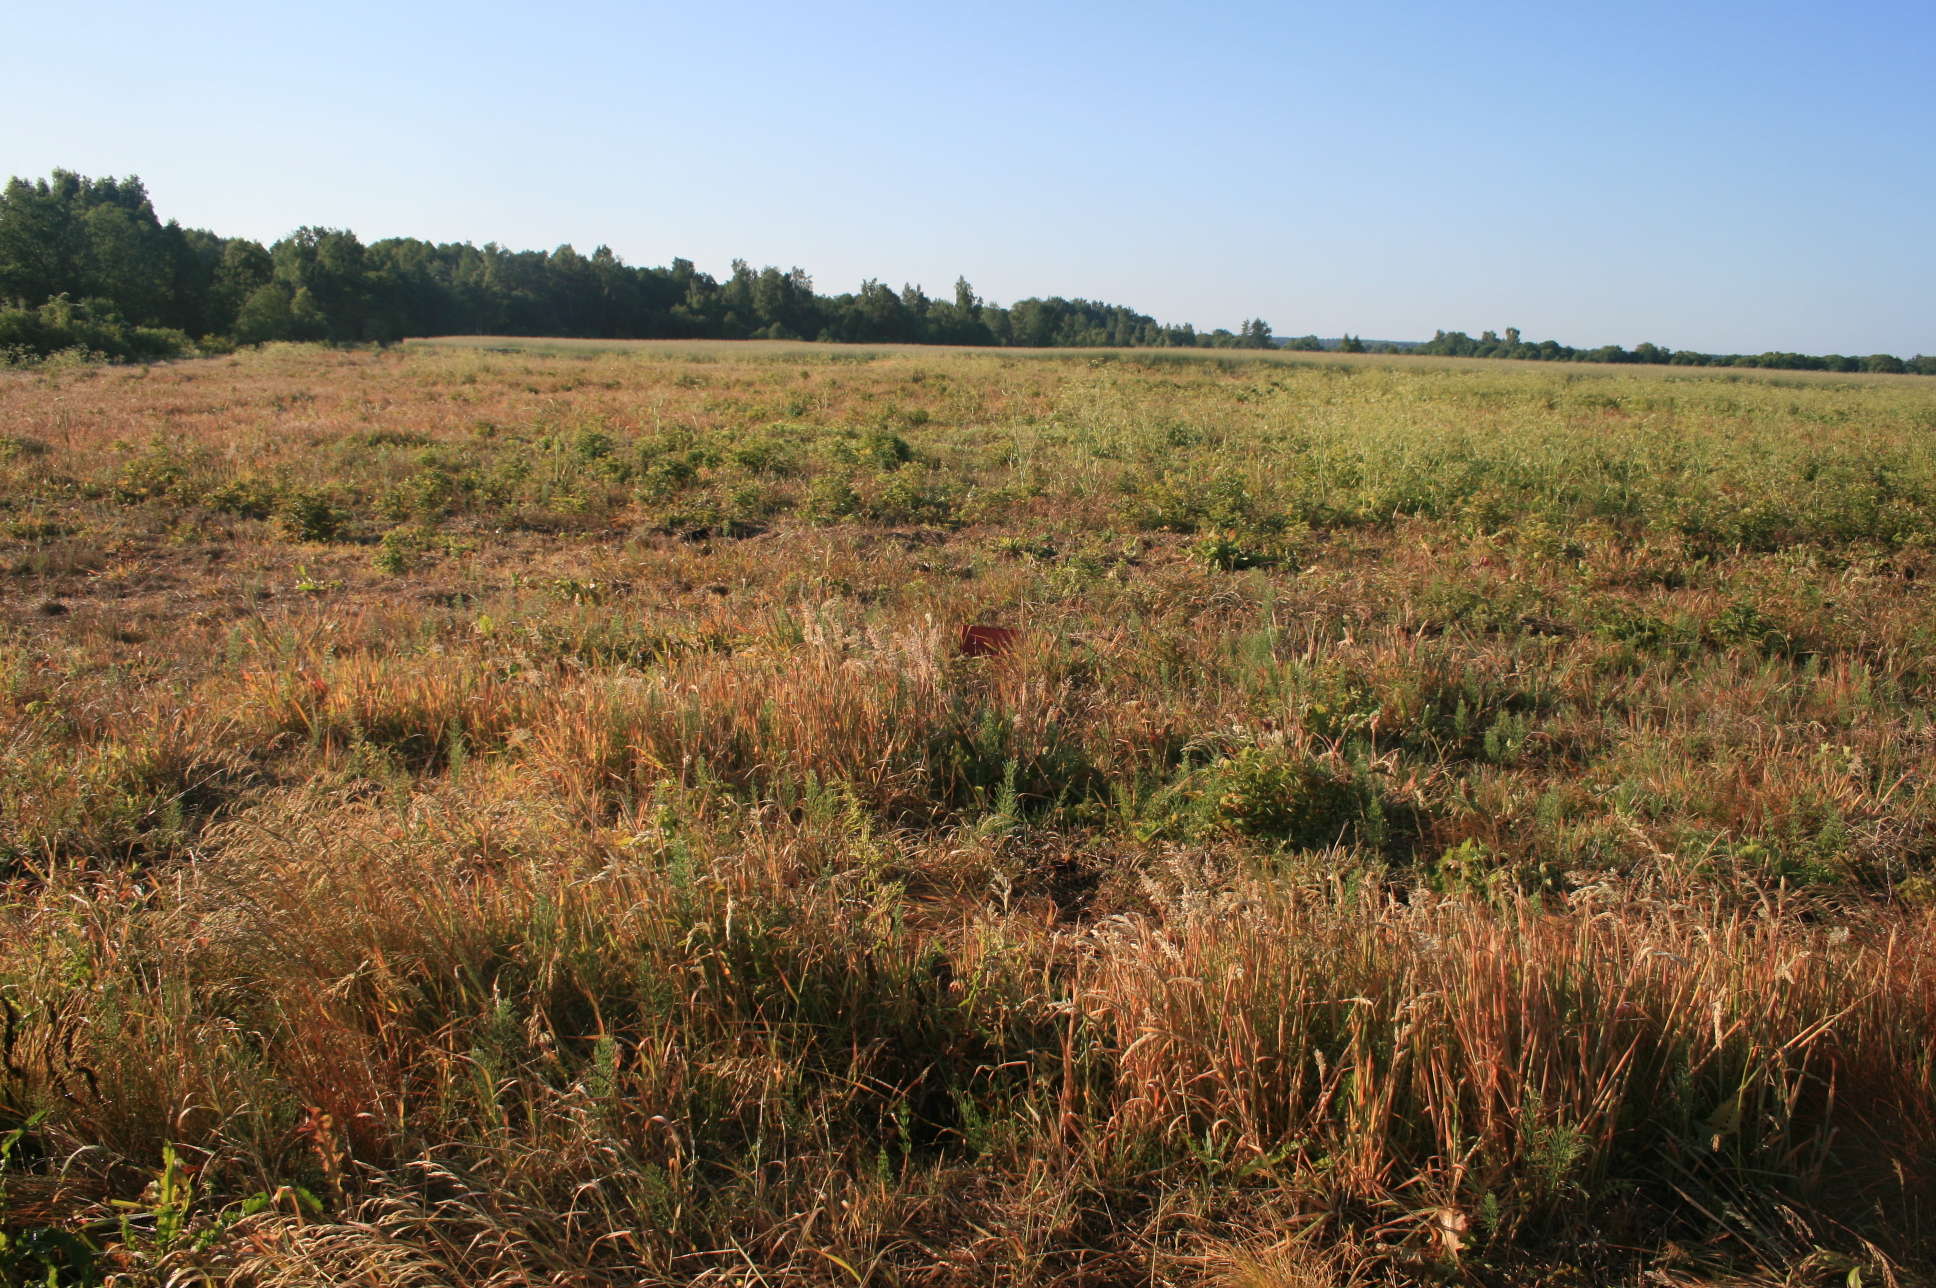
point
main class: Grassland
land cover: Spontaneously vegetated surfaces
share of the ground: > 75 %
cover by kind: herbaceous plants 100 %
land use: Fallow land
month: June
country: LT
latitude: 55.2315
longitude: 22.2755
